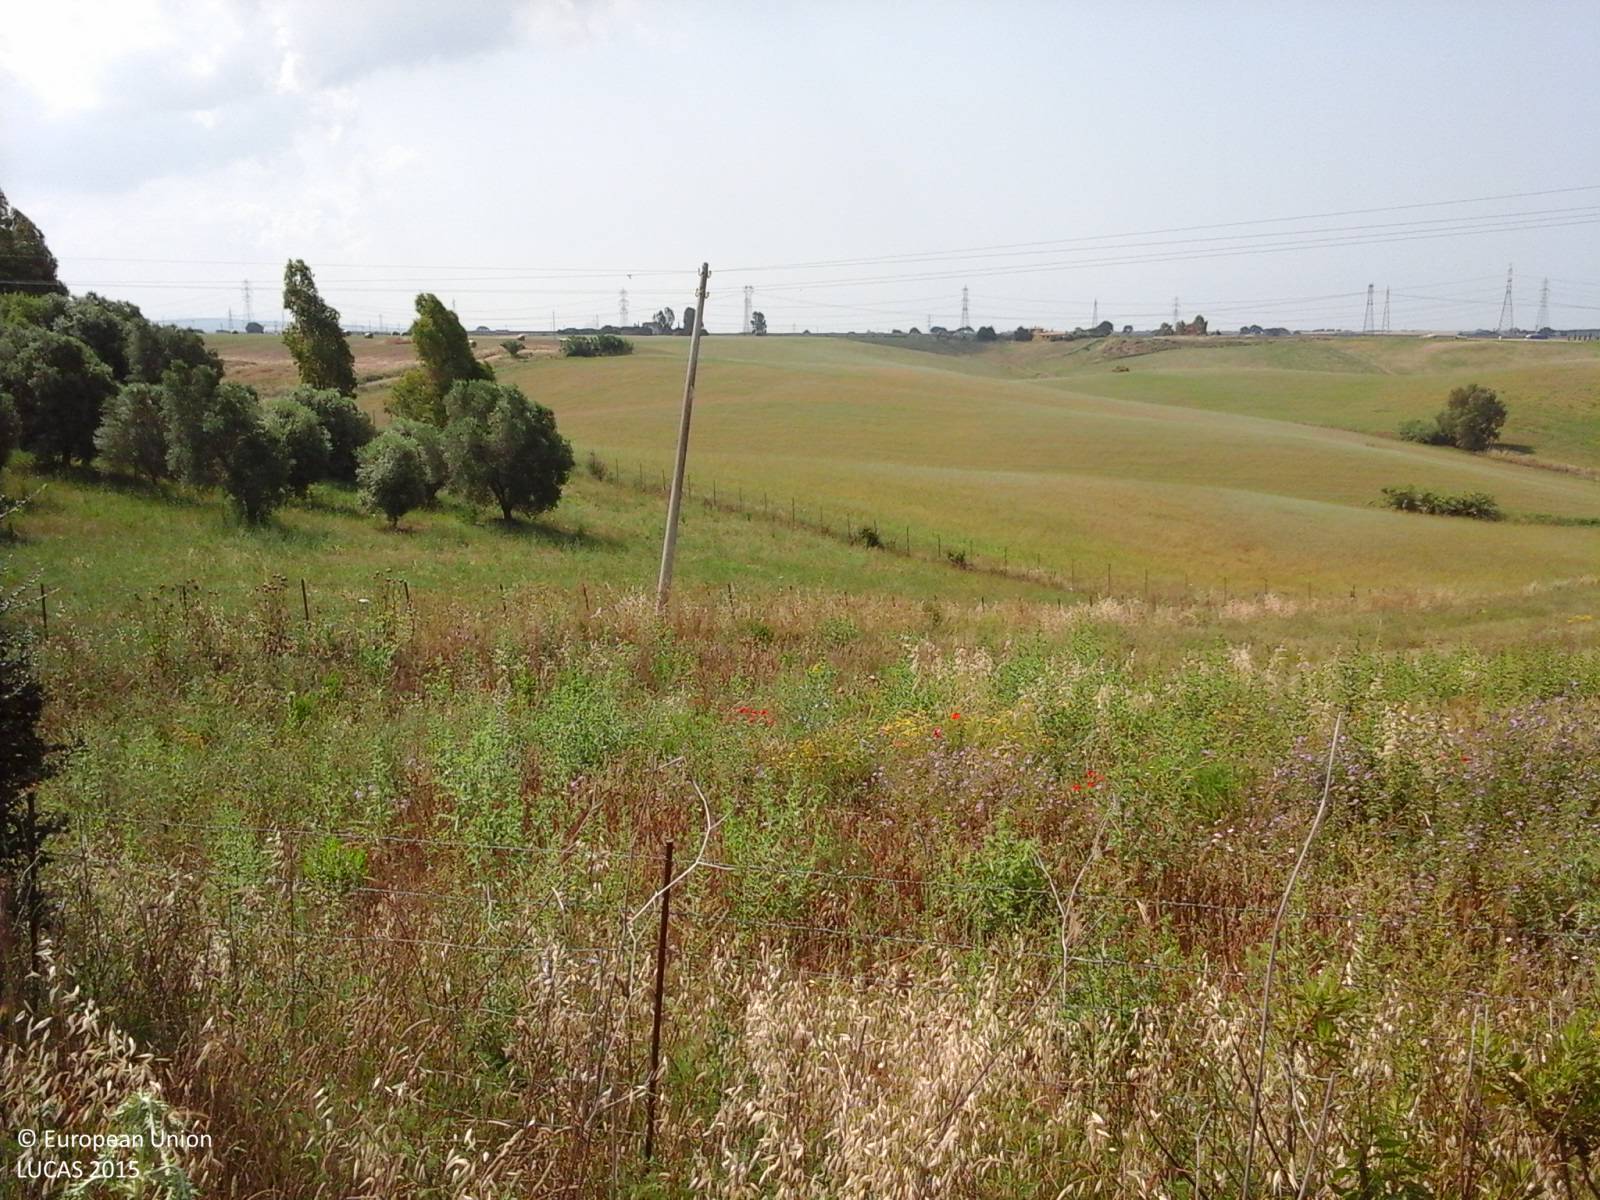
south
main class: Cropland
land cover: Oats
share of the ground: > 75 %
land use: Agriculture (excluding fallow land and kitchen gardens)
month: June
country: IT
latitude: 42.3695
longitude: 11.6578
